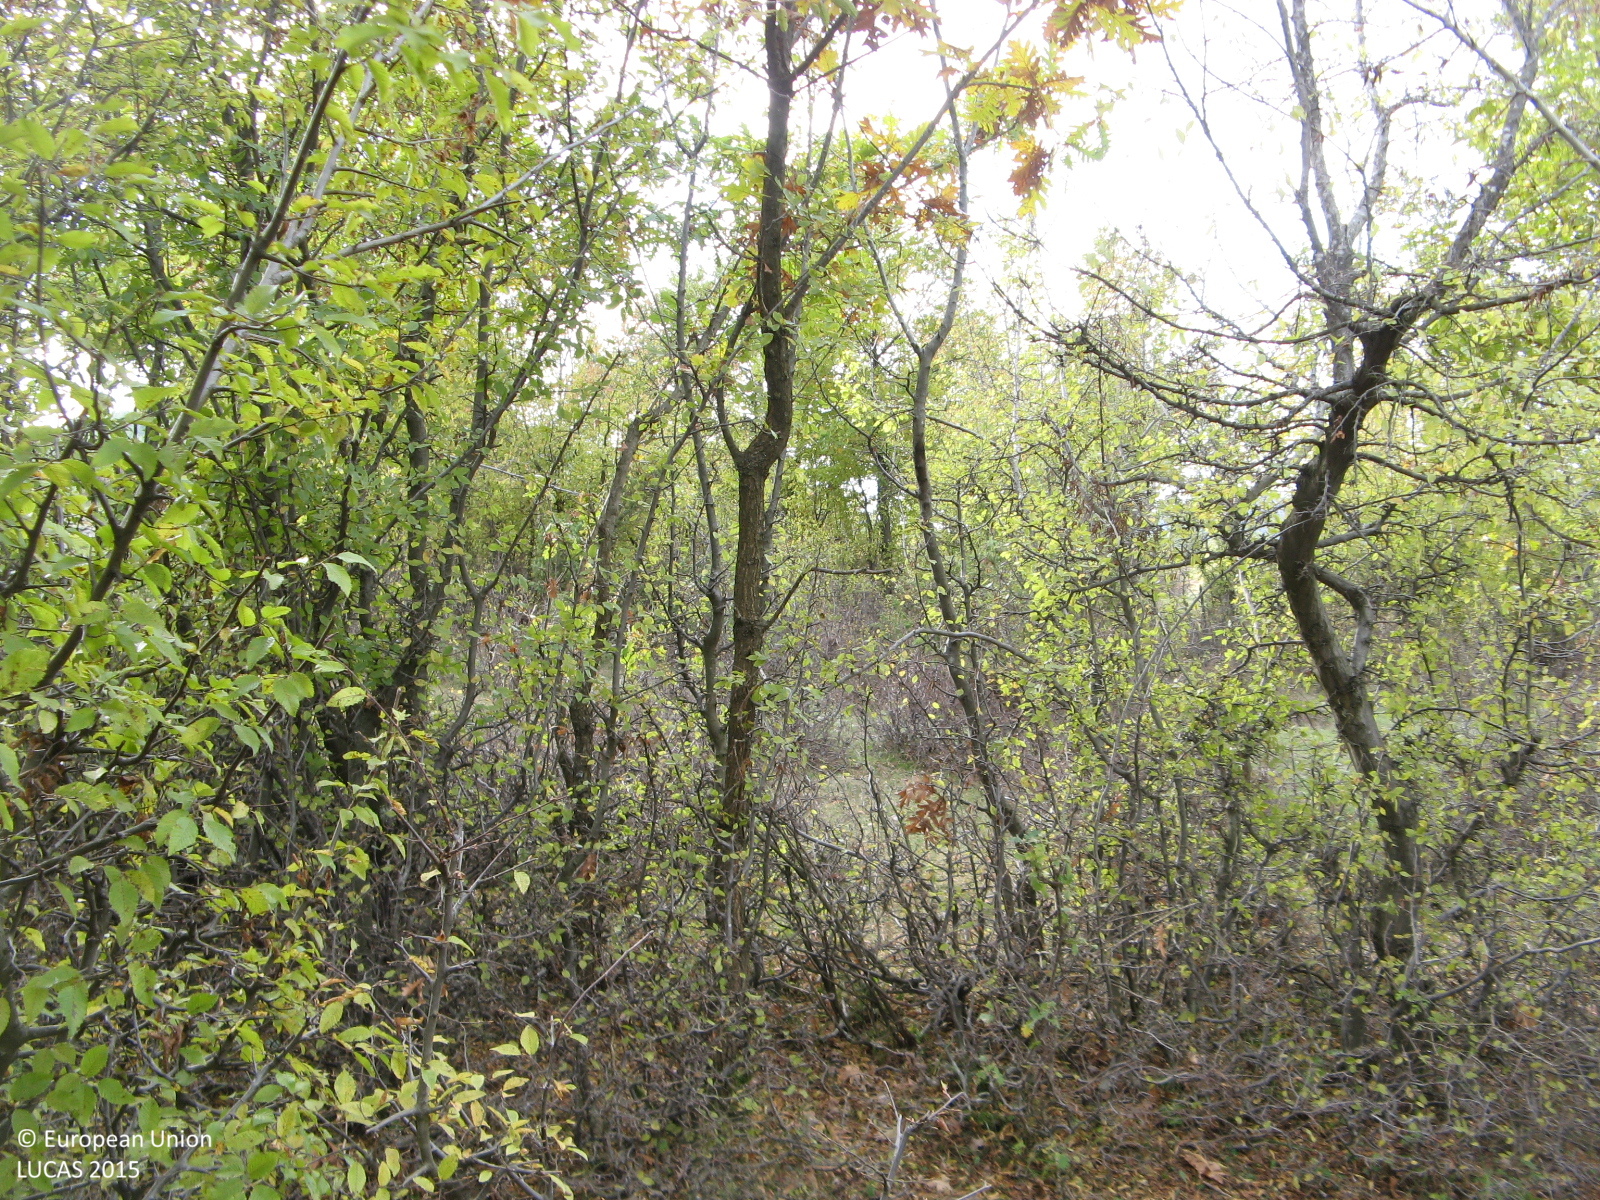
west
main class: Shrubland
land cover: Shrubland with sparse tree cover
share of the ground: > 75 %
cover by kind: shrubs 75 %, herbaceous plants 15 %, broadleaved forest trees 5 %, consolidated bare surface 5 %
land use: Agriculture (excluding fallow land and kitchen gardens)
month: November
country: BG
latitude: 41.4588
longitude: 25.3420
